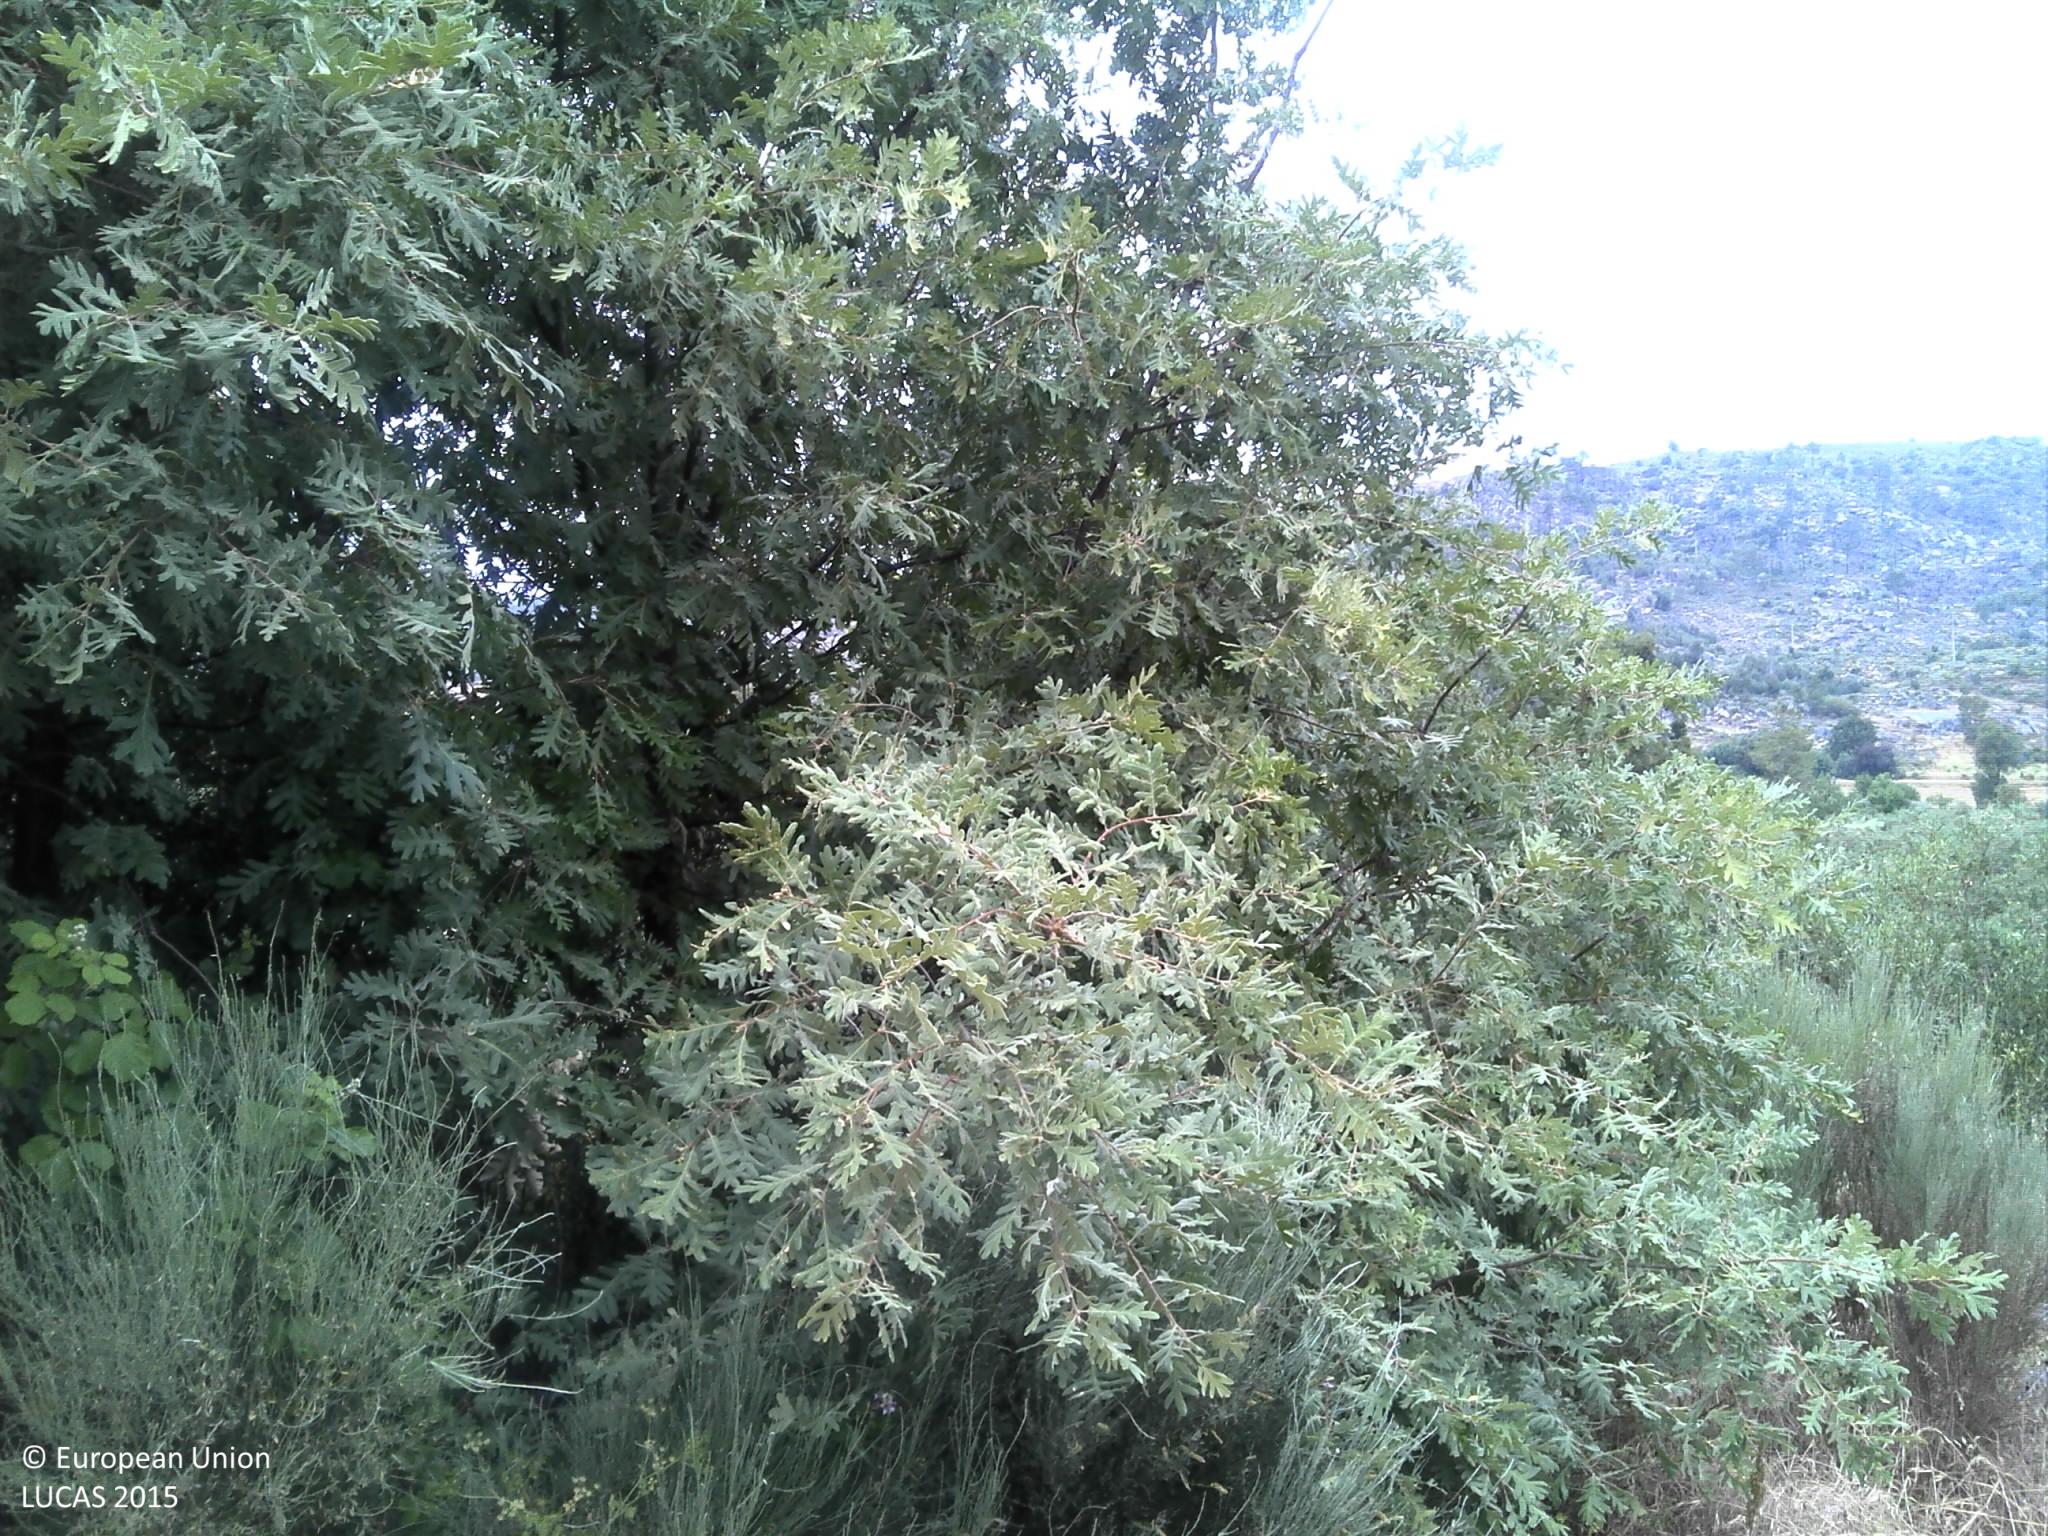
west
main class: Shrubland
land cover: Shrubland with sparse tree cover
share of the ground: 50 - 75 %
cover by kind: shrubs 55 %, herbaceous plants 30 %, broadleaved forest trees 5 %, unconsolidated bare surface 5 %
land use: Abandoned areas
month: June
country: PT
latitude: 40.3134
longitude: -7.2465
